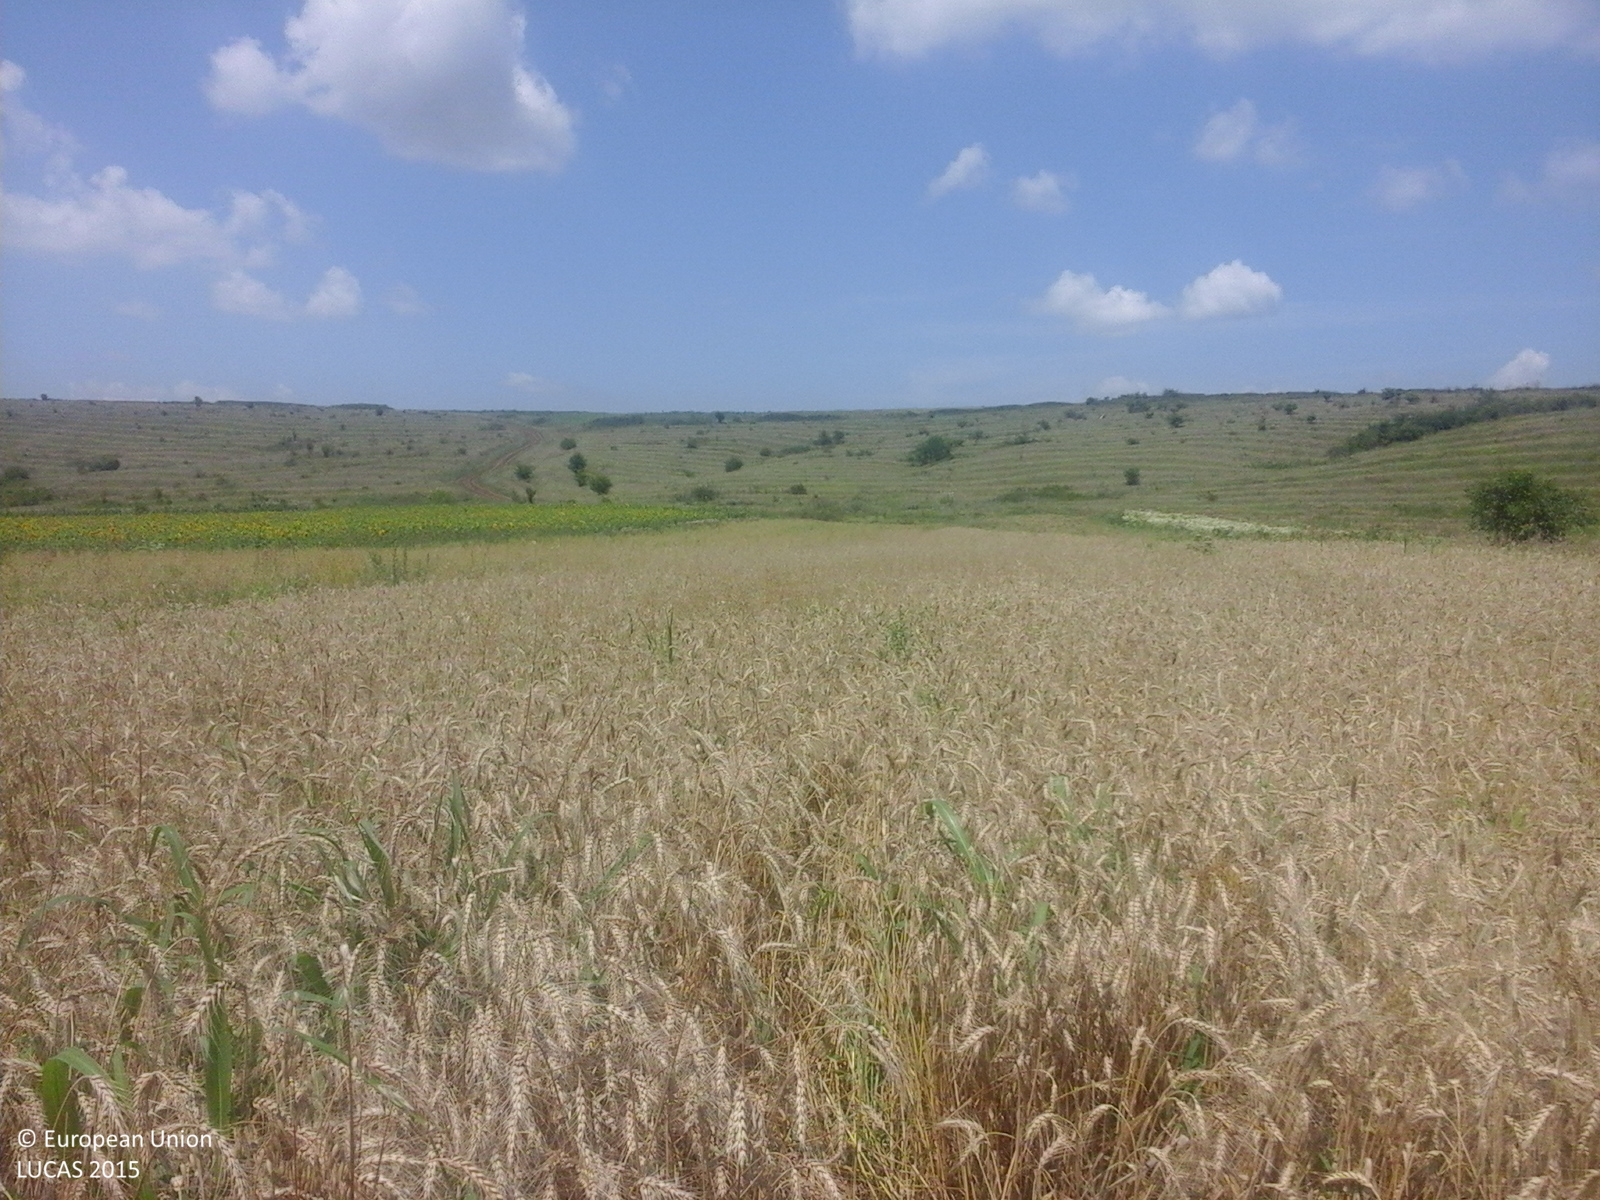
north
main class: Cropland
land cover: Common wheat
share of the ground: > 75 %
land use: Agriculture (excluding fallow land and kitchen gardens)
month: July
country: RO
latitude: 44.2140
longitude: 24.1678
